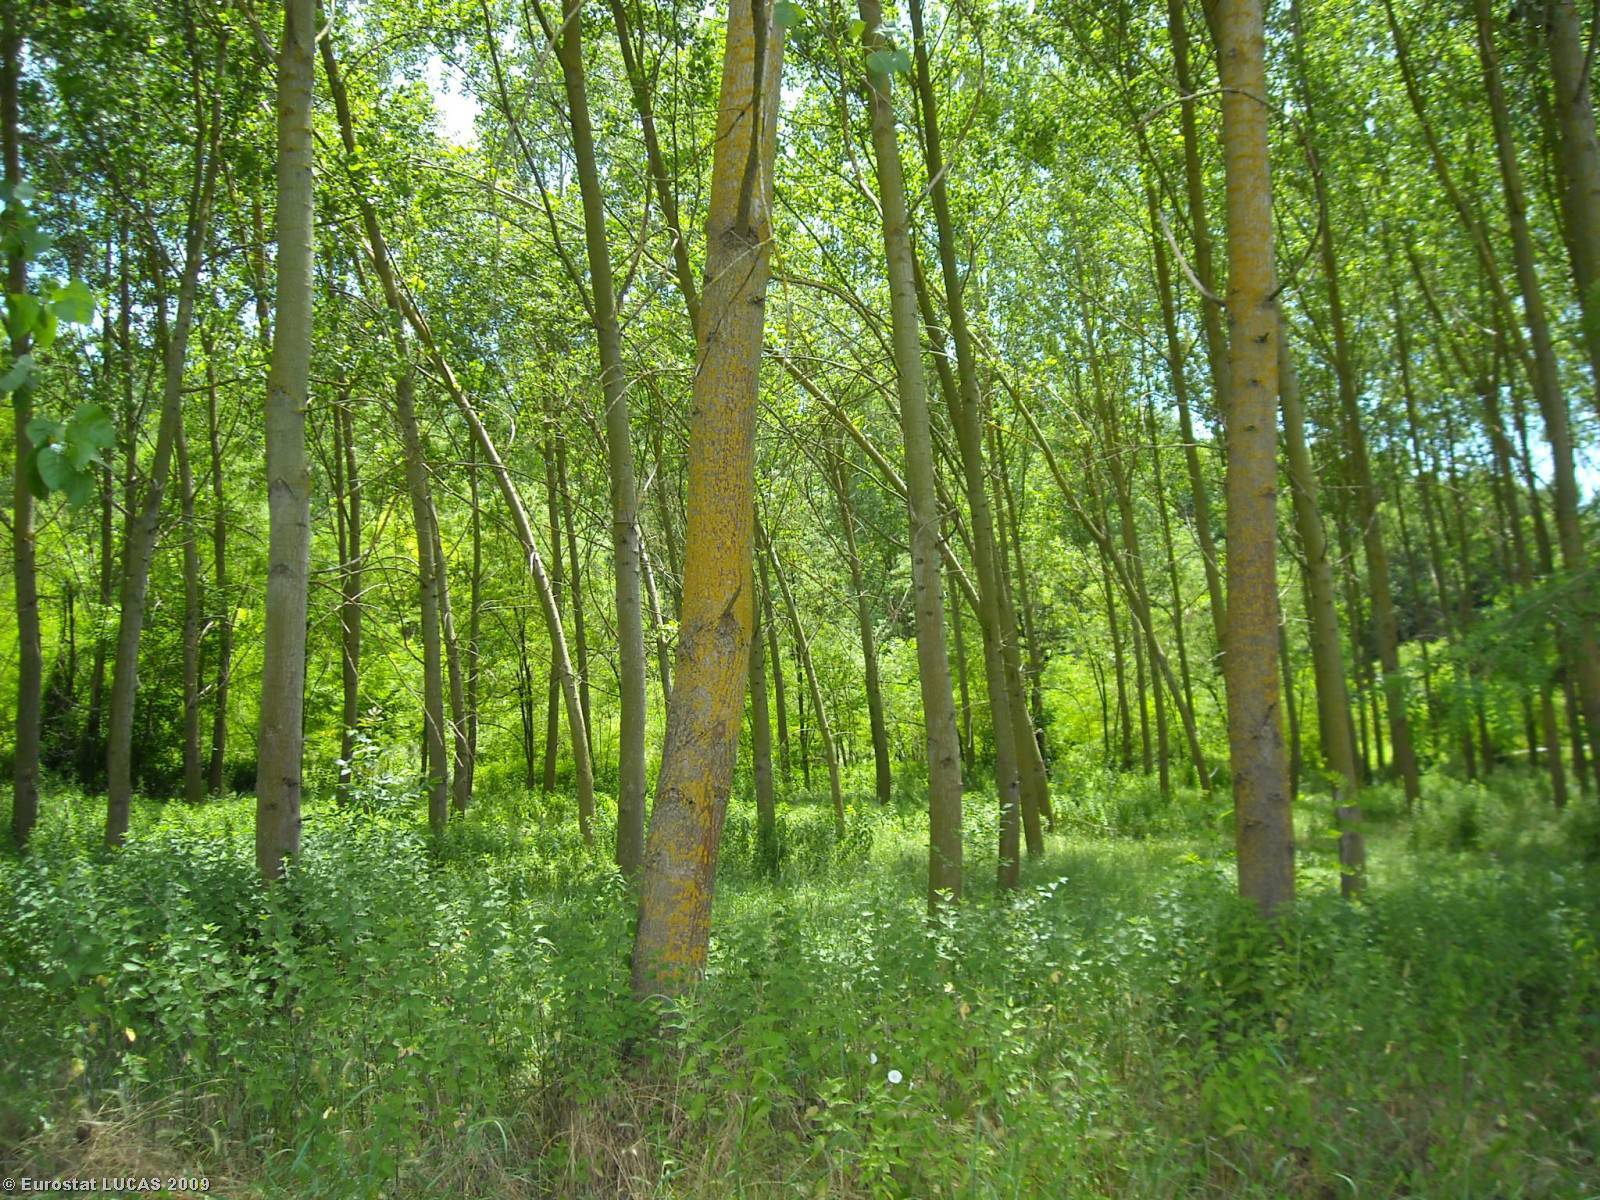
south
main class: Grassland
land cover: Spontaneously vegetated surfaces
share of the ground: > 75 %
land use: Fallow land
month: June
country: IT
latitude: 45.0003
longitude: 8.0880
